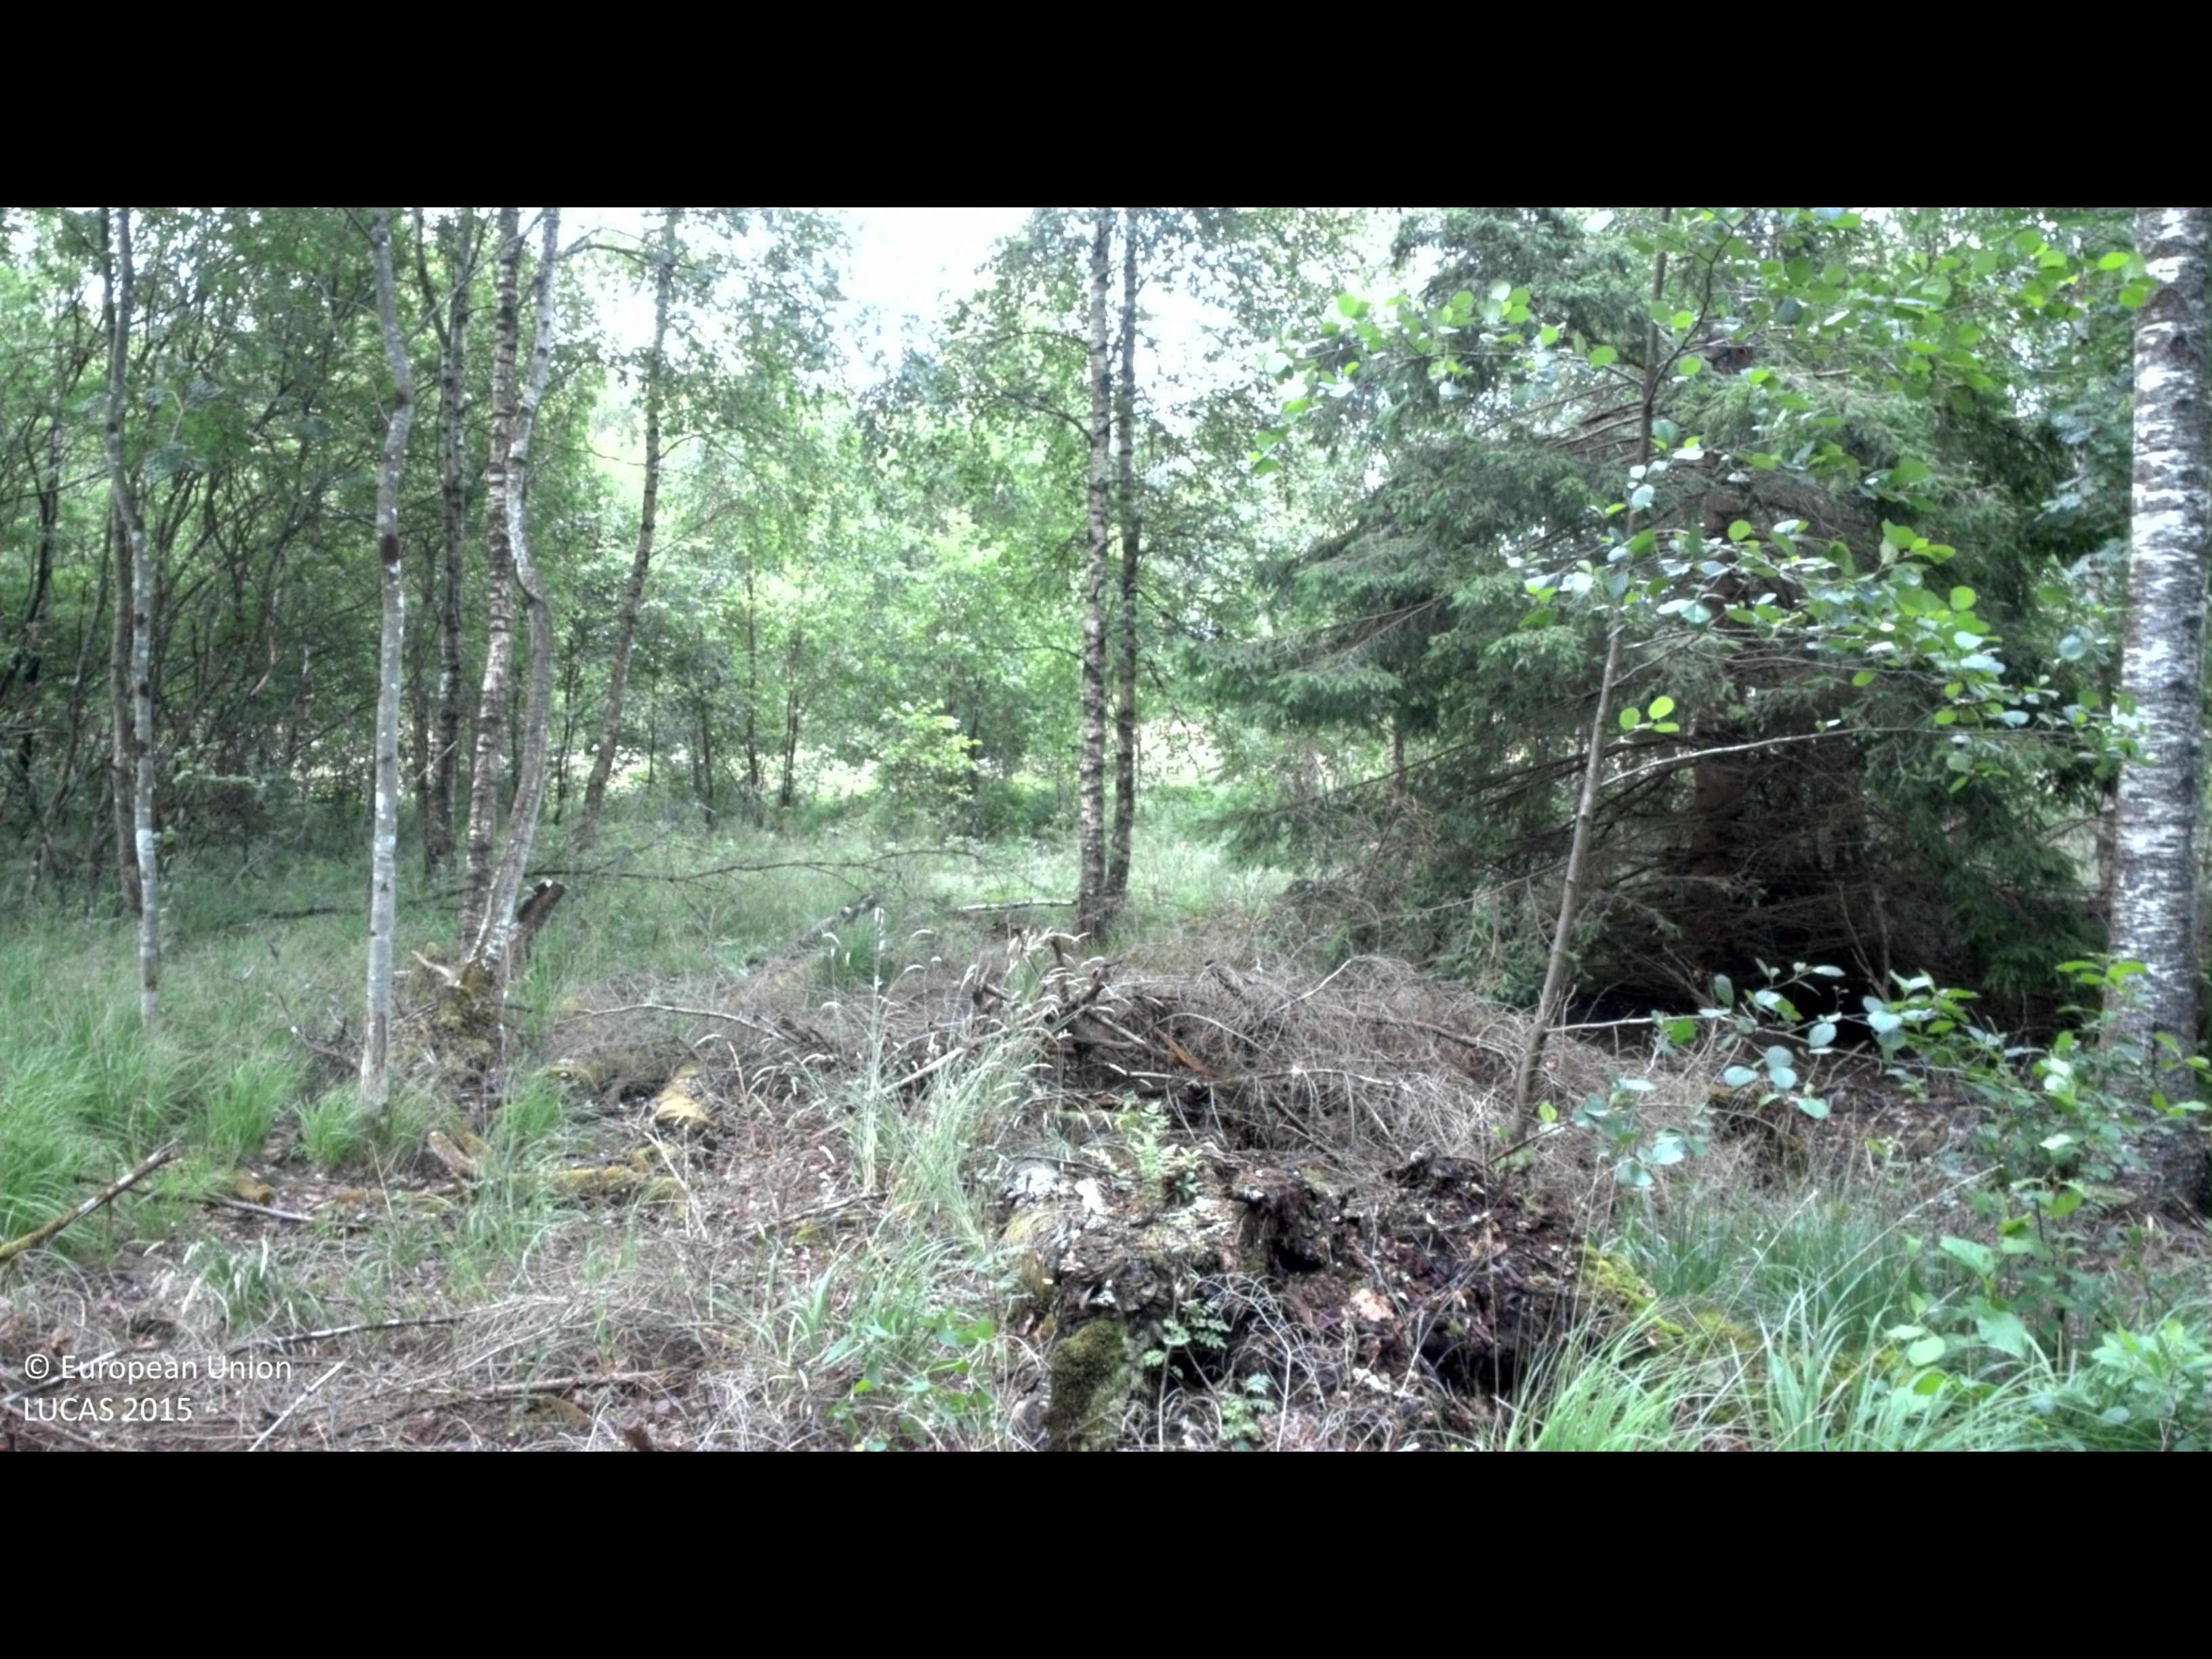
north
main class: Woodland
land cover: Broadleaved woodland
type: boreal forest
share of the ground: 50 - 75 %
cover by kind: broadleaved forest trees 55 %, herbaceous plants 30 %, shrubs 15 %
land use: Forestry
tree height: > 5 m
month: July
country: SE
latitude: 56.6546
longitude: 13.7648
